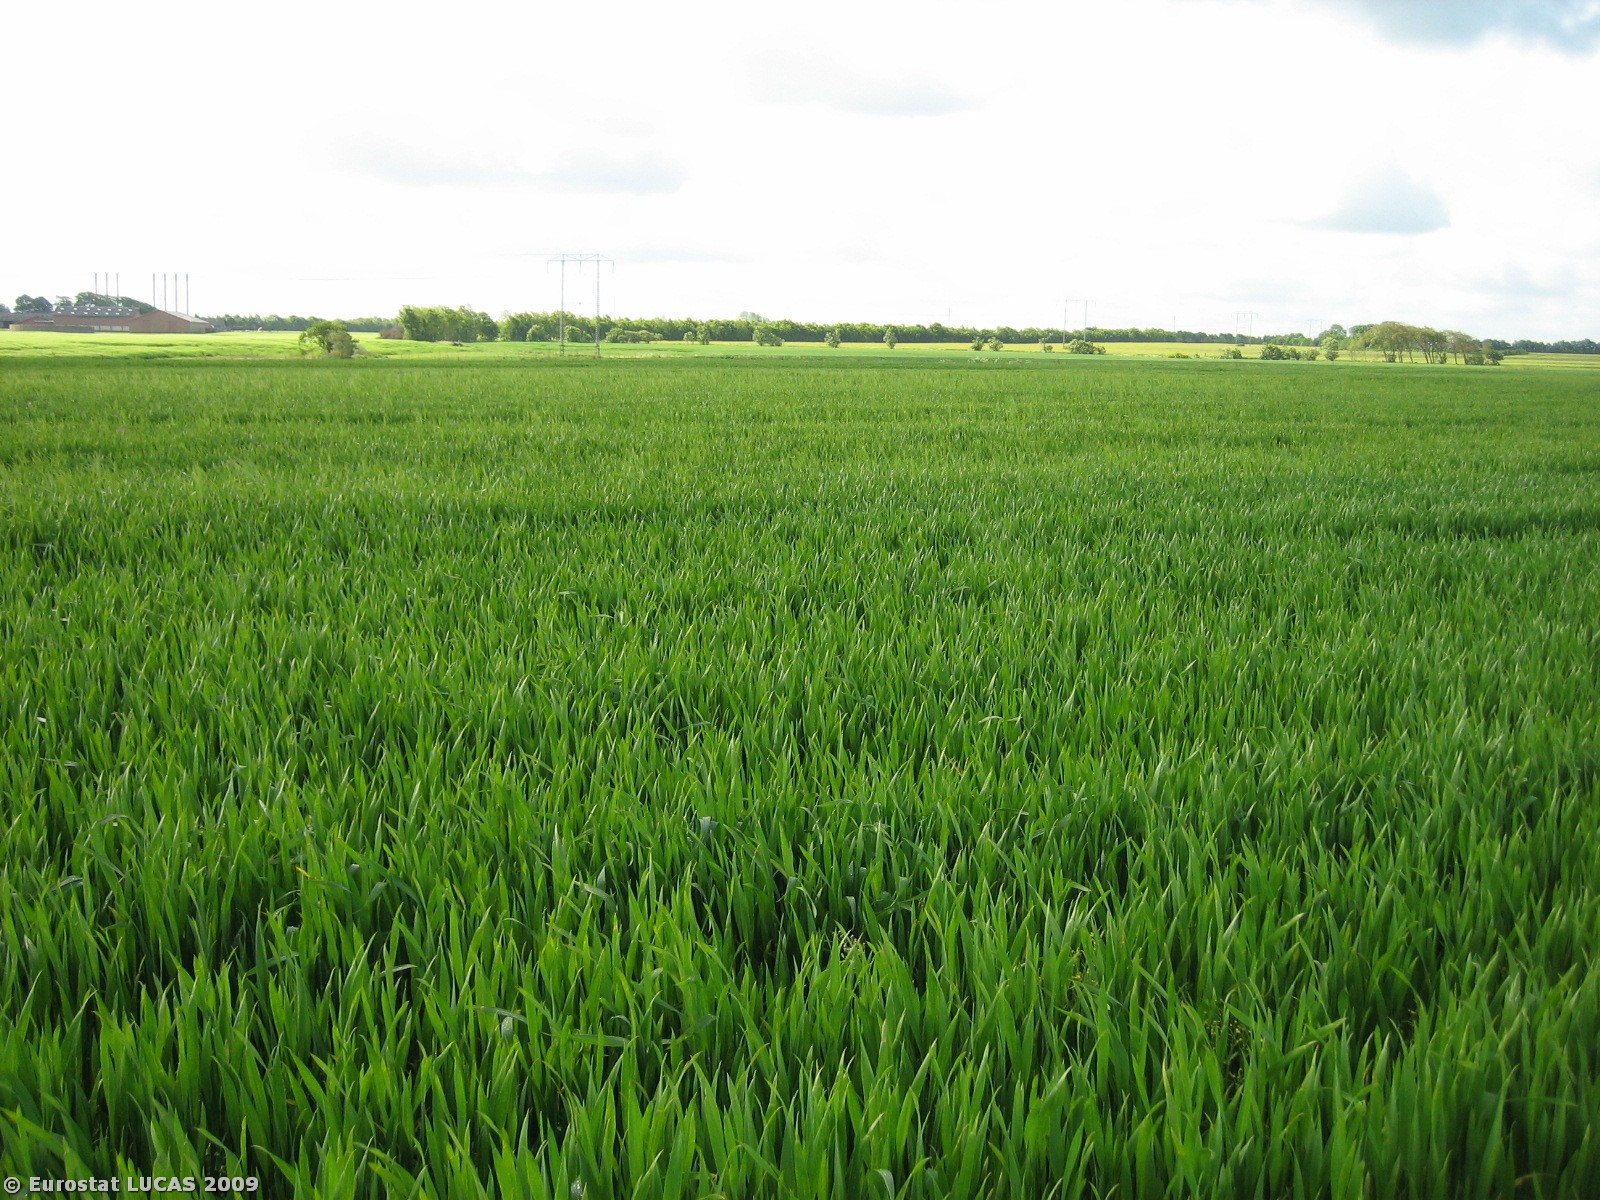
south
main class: Cropland
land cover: Barley
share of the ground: > 75 %
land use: Agriculture (excluding fallow land and kitchen gardens)
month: May
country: DK
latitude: 56.1293
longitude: 8.9233
